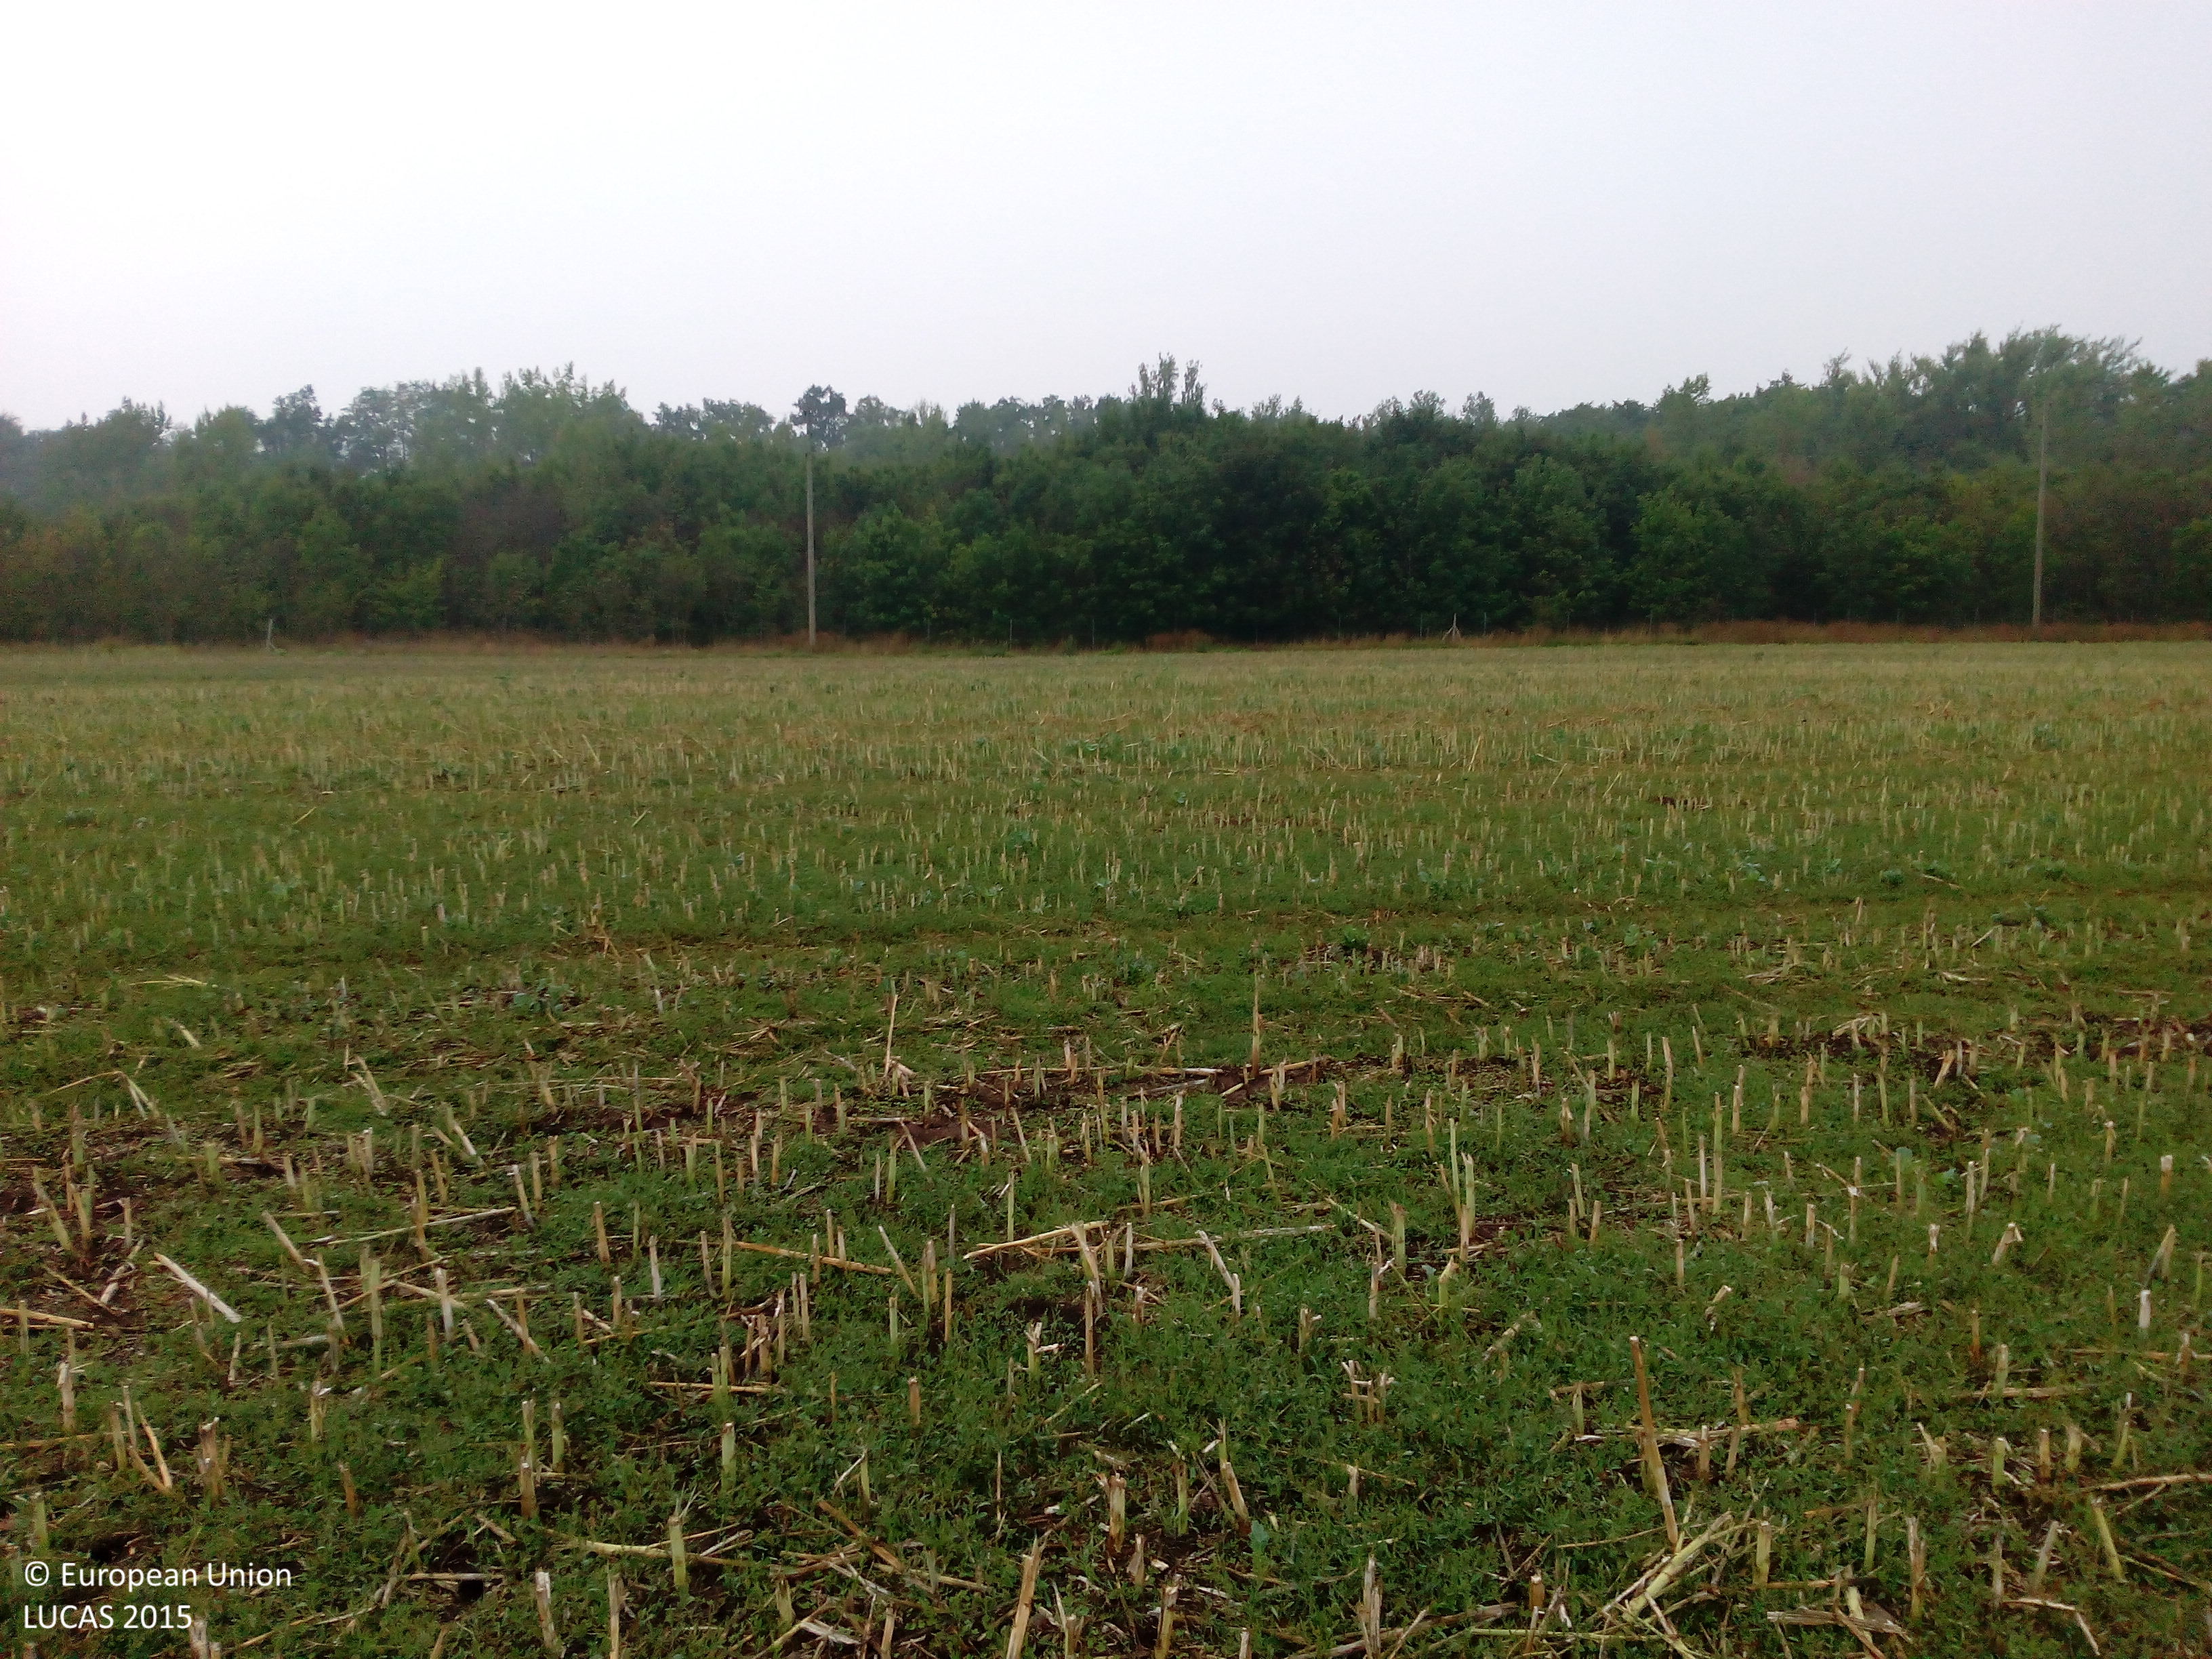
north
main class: Cropland
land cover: Rape and turnip rape
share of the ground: < 10 %
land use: Agriculture (excluding fallow land and kitchen gardens)
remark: Harvested field
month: August
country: DE
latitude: 50.9002
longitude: 10.8671
